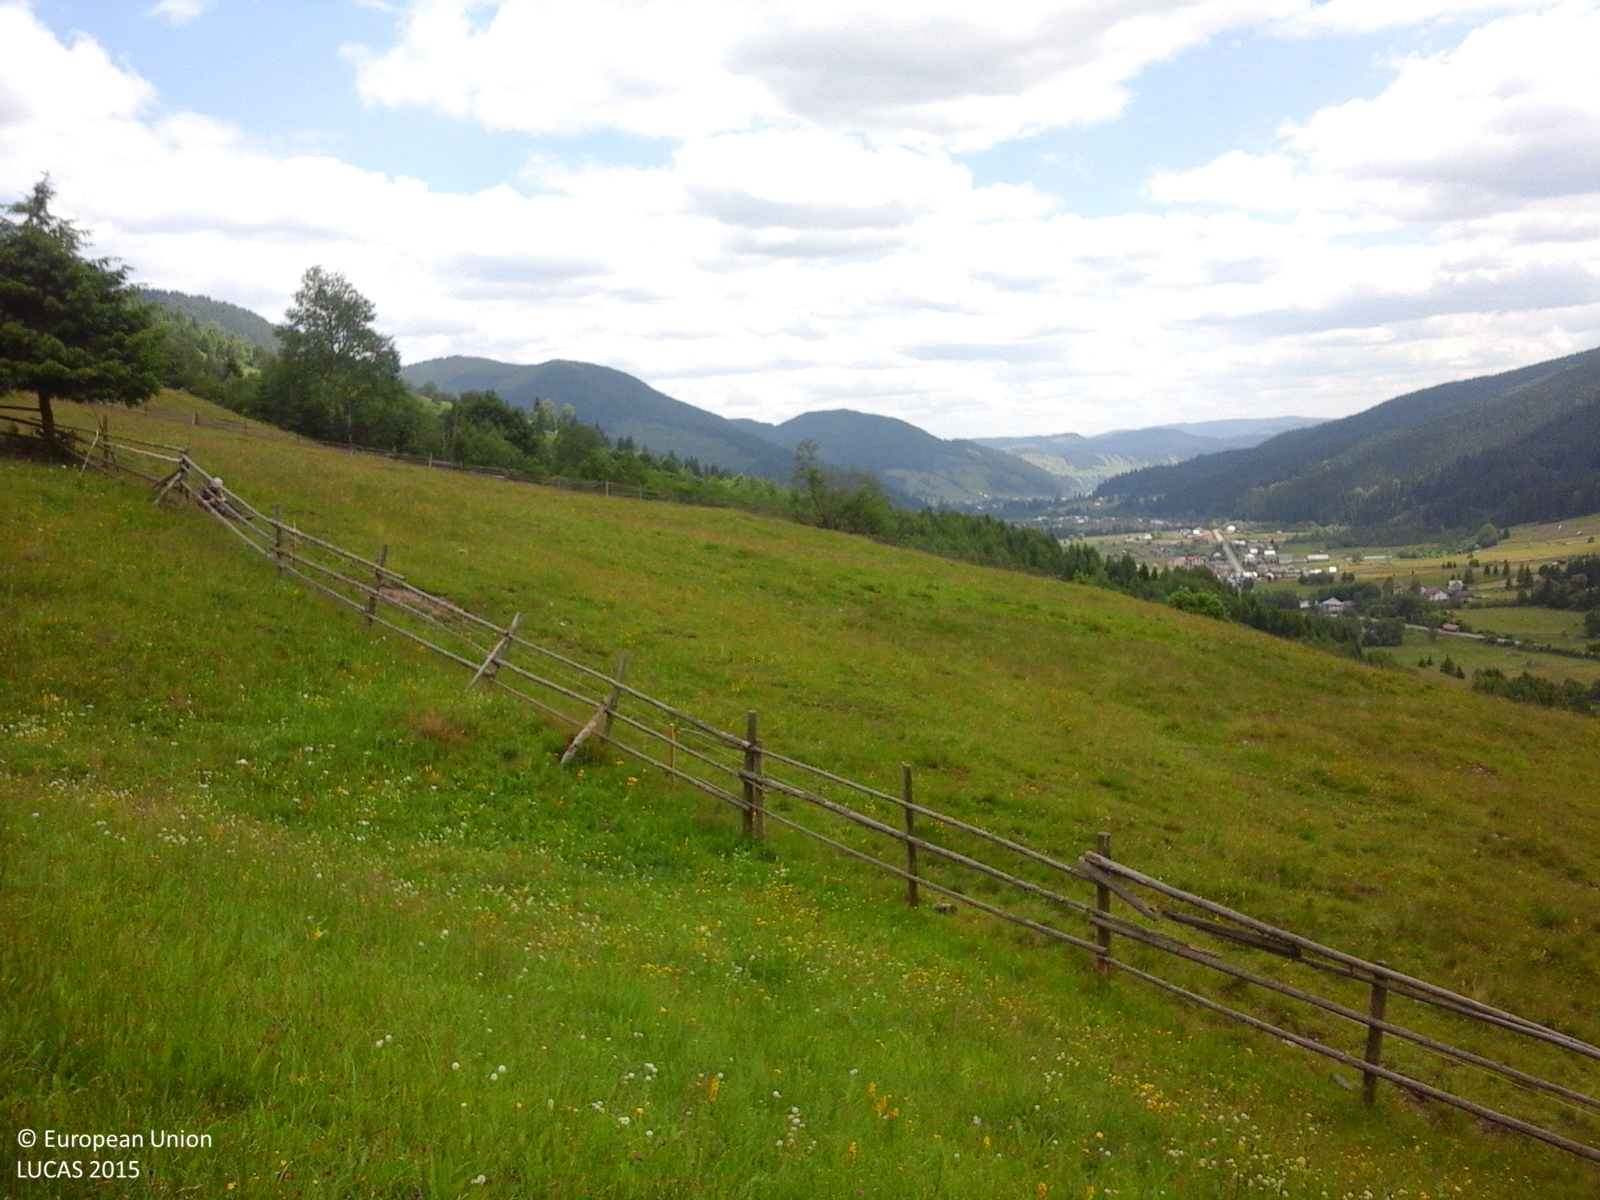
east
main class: Grassland
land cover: Grassland without tree/shrub cover
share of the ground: > 75 %
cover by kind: herbaceous plants 100 %
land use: Agriculture (excluding fallow land and kitchen gardens)
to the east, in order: Grassland without tree/shrub cover; Fences; Grassland without tree/shrub cover; Fences; Grassland without tree/shrub cover; Broadleaved woodland; Grassland with sparse tree/shrub cover
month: June
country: RO
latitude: 47.5262
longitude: 25.2108
